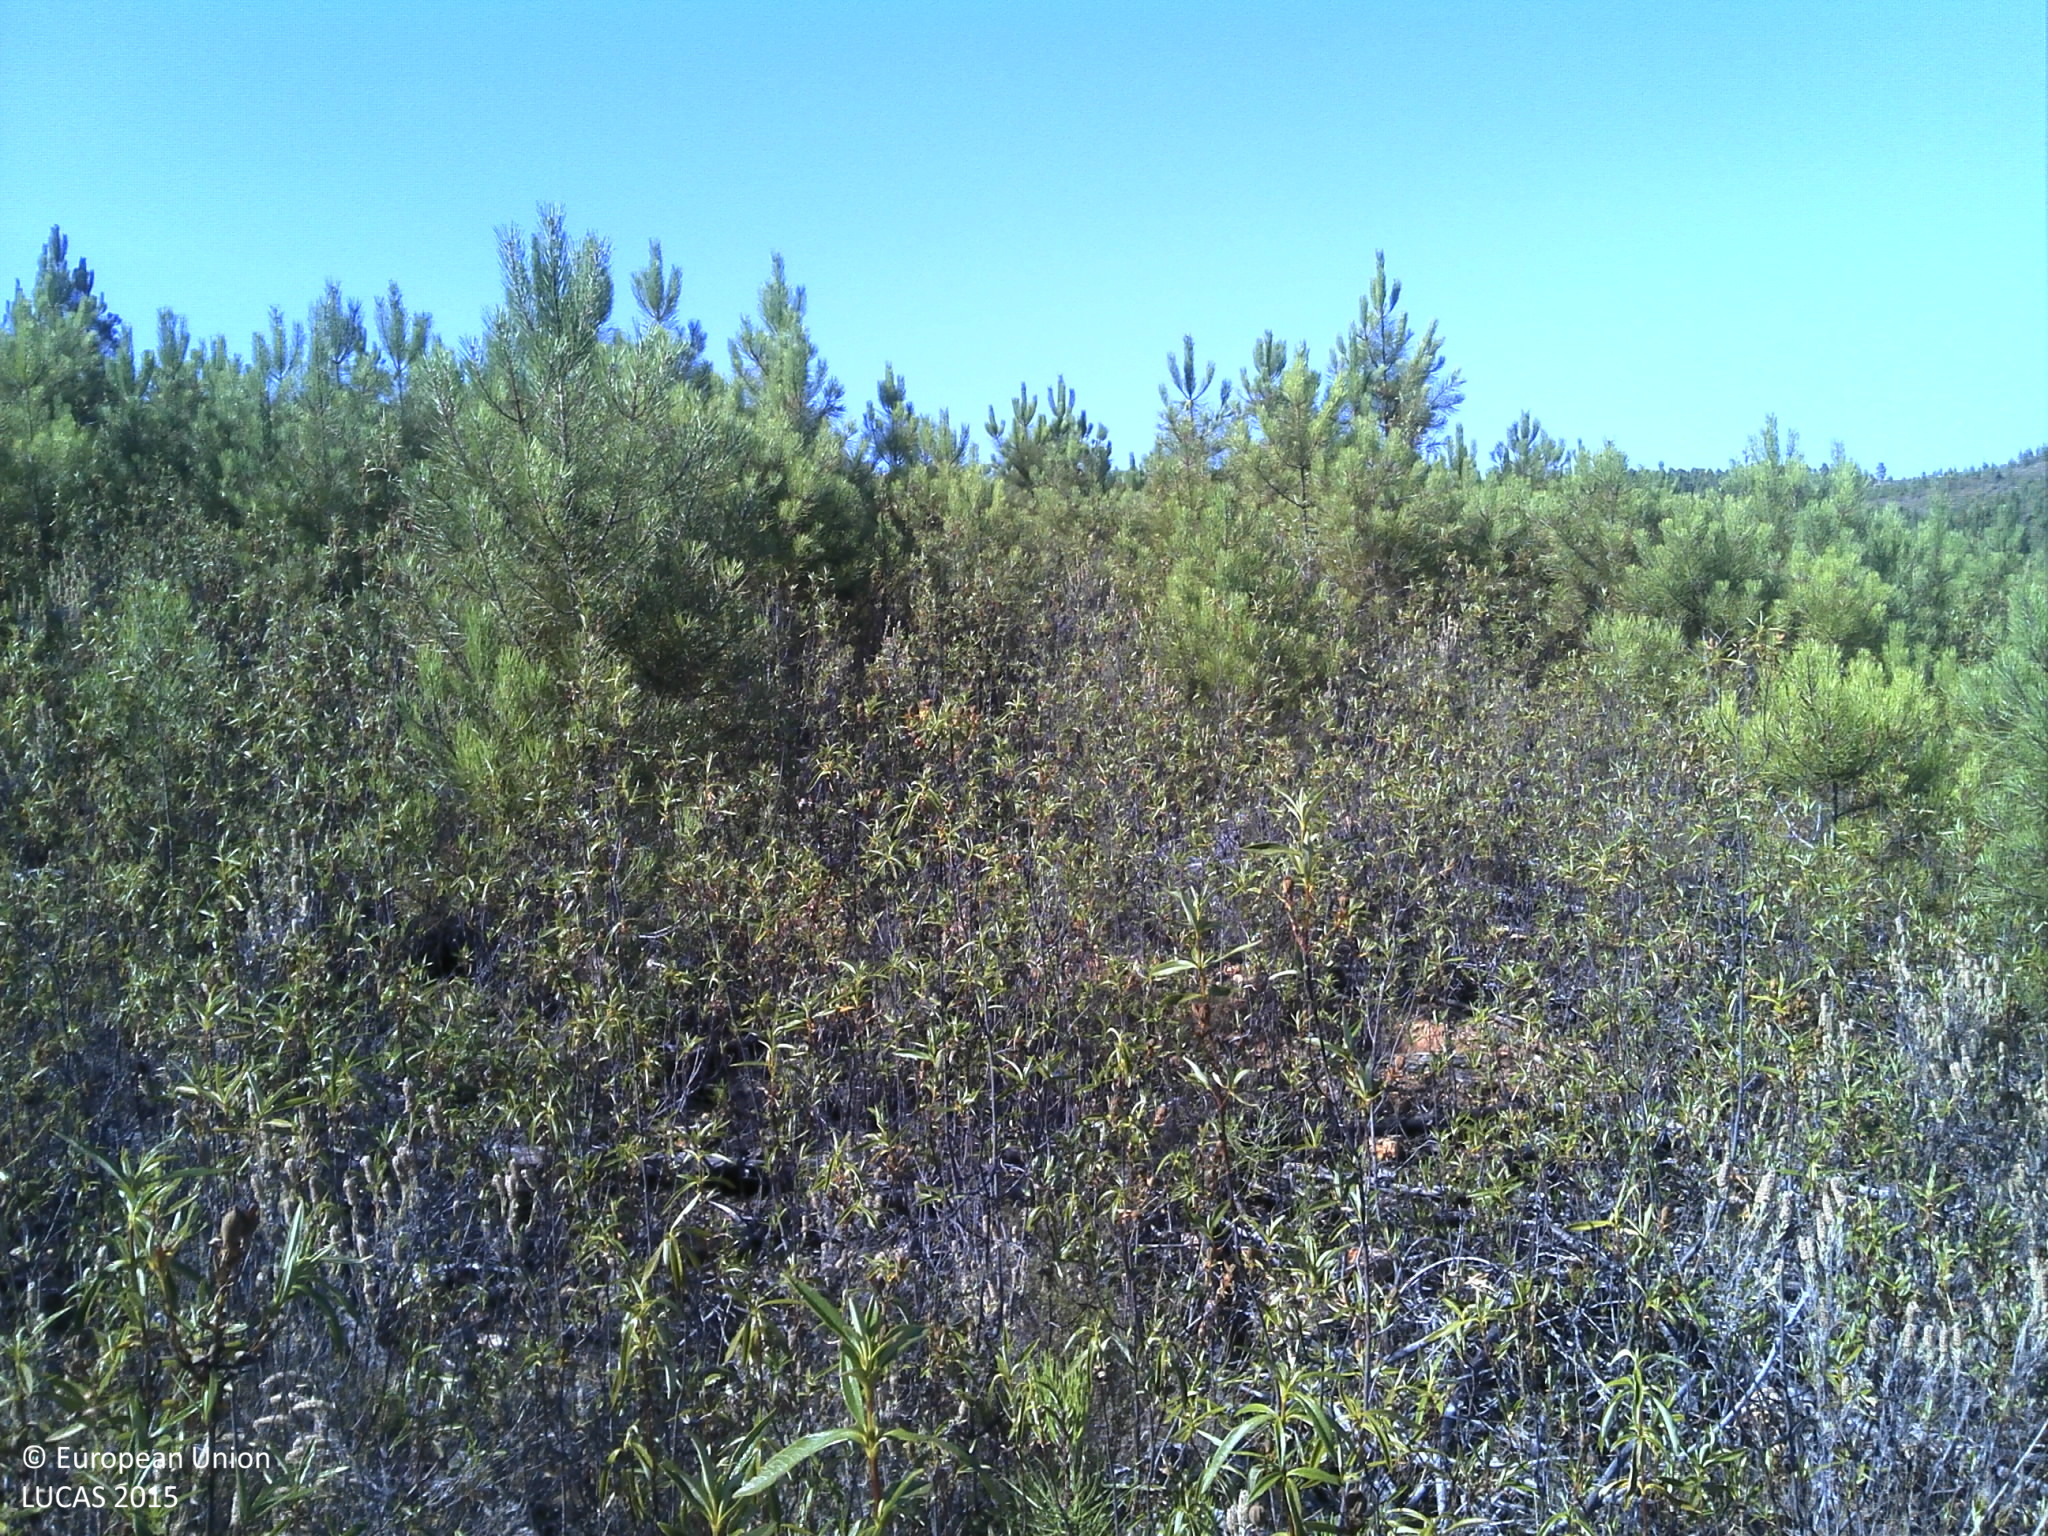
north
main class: Shrubland
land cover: Shrubland with sparse tree cover
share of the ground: 50 - 75 %
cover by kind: shrubs 70 %, unconsolidated bare surface 25 %, coniferous forest trees 5 %
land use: Forestry
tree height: < 5 m
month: July
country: PT
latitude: 39.9280
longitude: -7.6444
